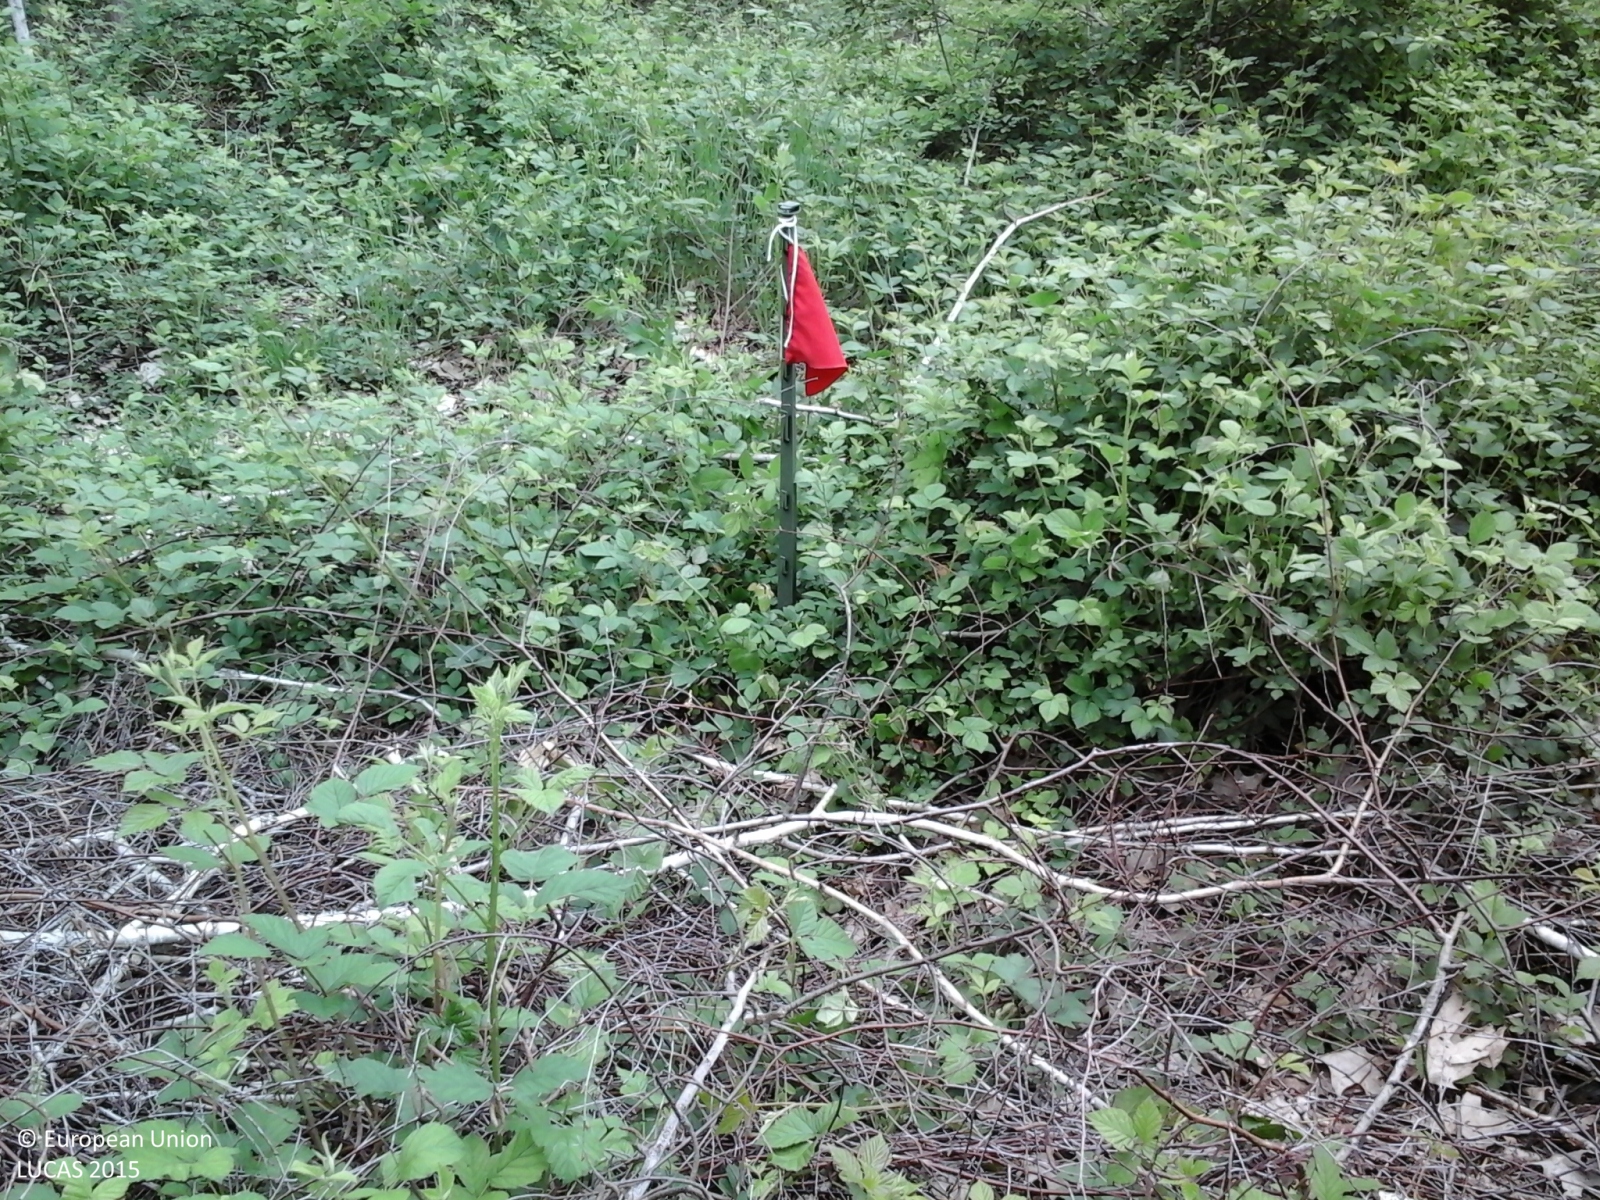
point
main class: Woodland
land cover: Broadleaved woodland
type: thermophilous deciduous forest
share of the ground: > 75 %
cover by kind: broadleaved forest trees 100 %
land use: Forestry
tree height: > 5 m
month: May
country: IT
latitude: 45.5839
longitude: 8.5029
